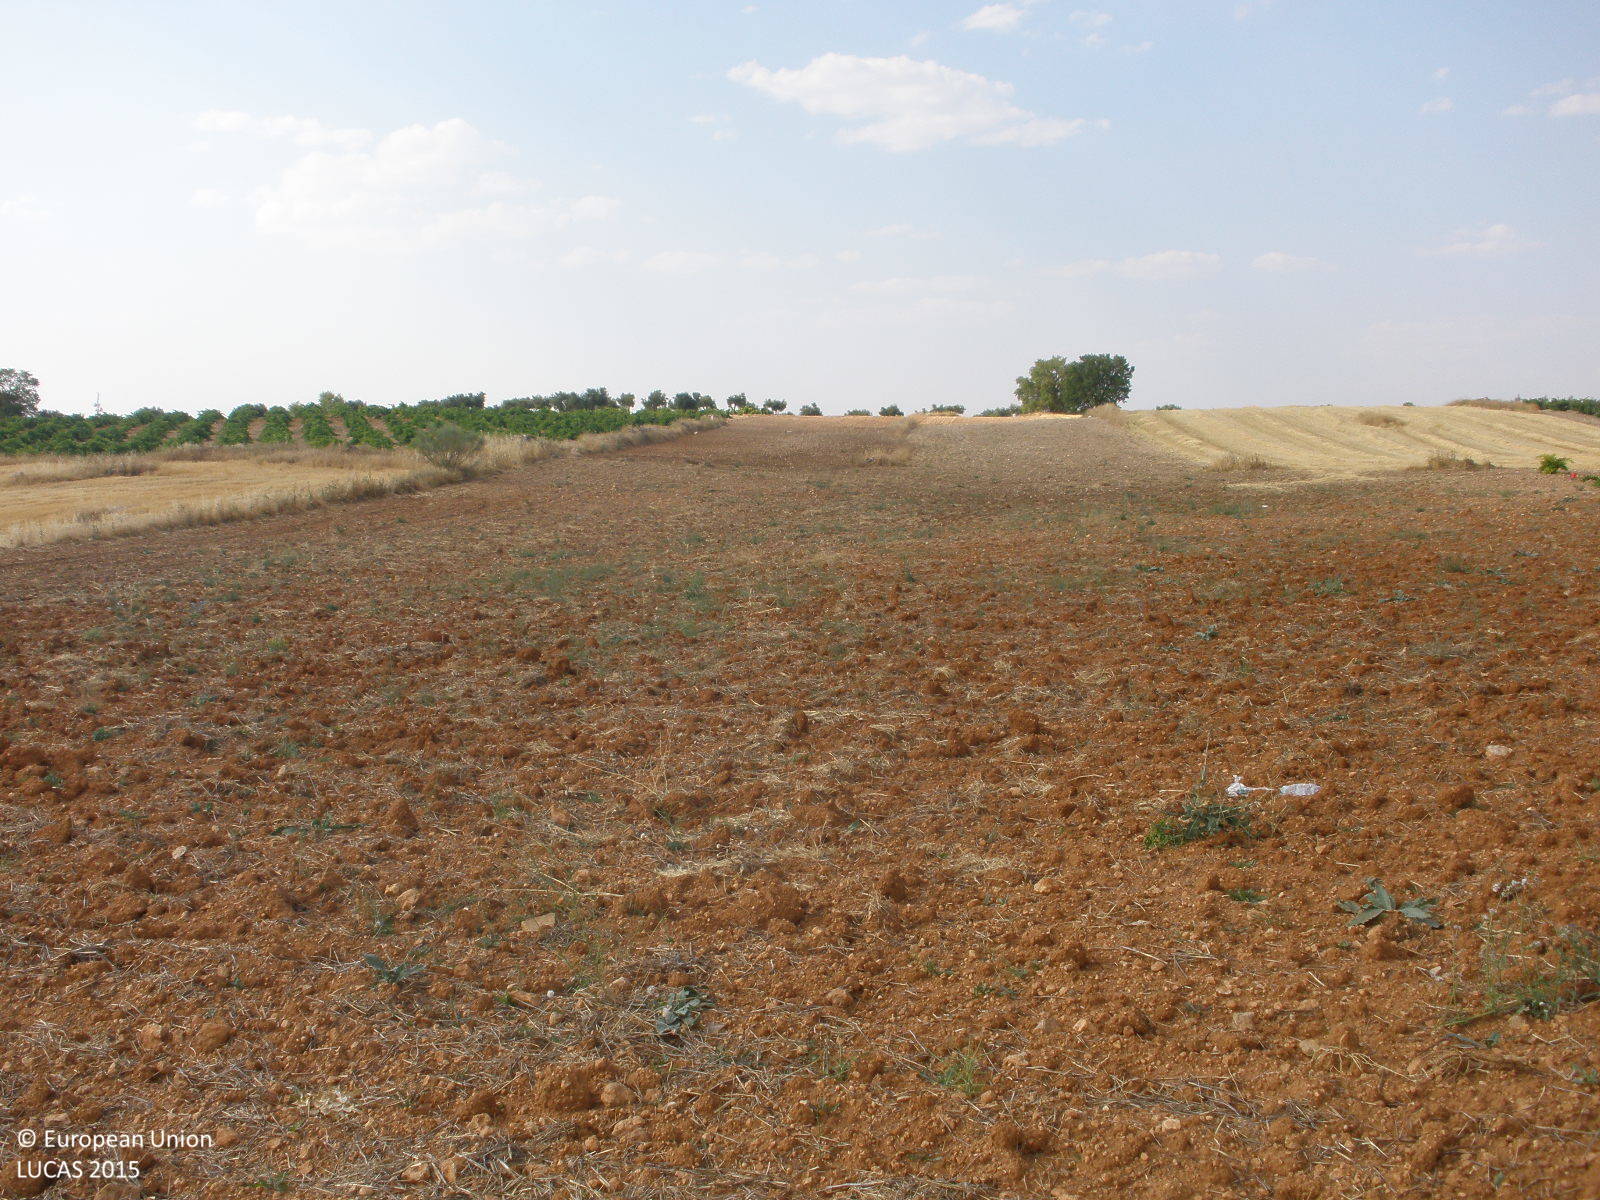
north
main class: Grassland
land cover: Spontaneously vegetated surfaces
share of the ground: 10 - 25 %
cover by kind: unconsolidated bare surface 80 %, herbaceous plants 20 %
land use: Fallow land
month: June
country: ES
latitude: 40.1472
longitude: -3.2815
